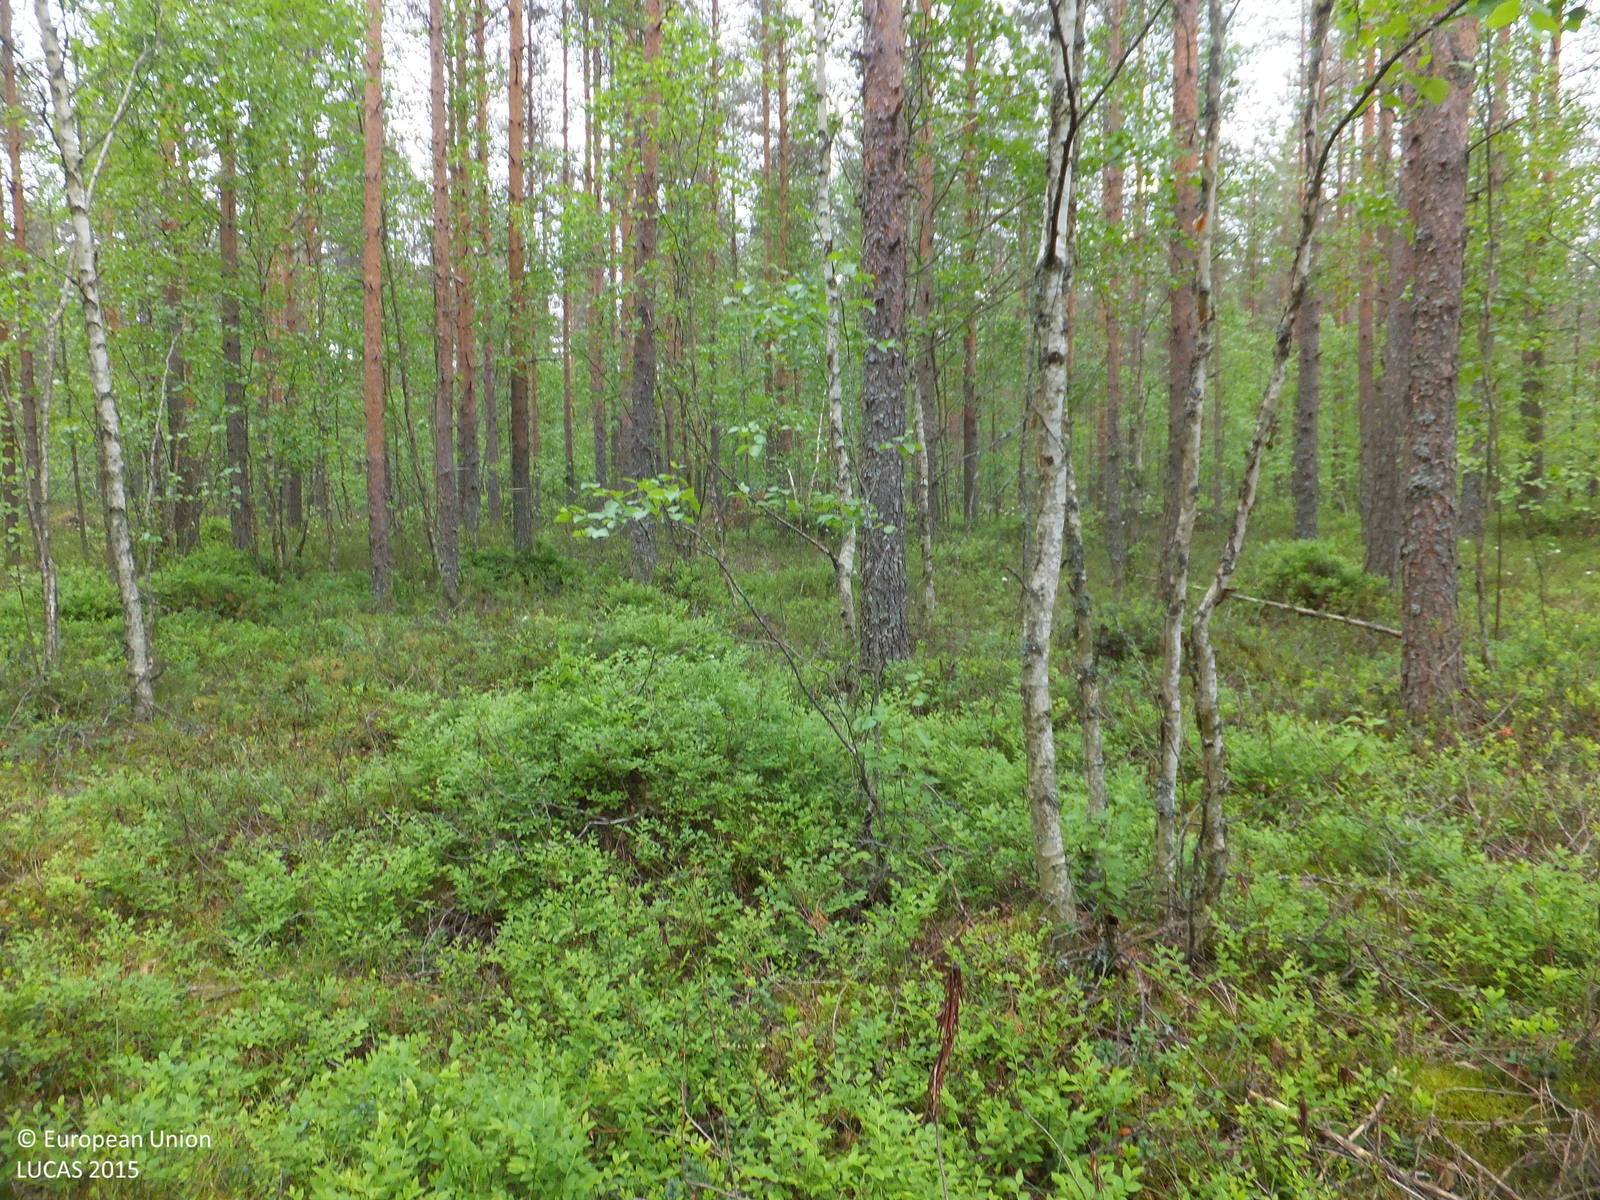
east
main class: Woodland
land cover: Pine dominated mixed woodland
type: boreal forest
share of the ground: > 75 %
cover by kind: coniferous forest trees 45 %, broadleaved forest trees 25 %, shrubs 20 %, lichens and mosses 10 %
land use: Forestry
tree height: > 5 m
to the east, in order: Pine dominated mixed woodland; Ditches and canals; Pine dominated mixed woodland; Ditches and canals; Groves; Tracks; Pine dominated mixed woodland; Ditches and canals; Pine dominated mixed woodland; Ditches and canals; Pine dominated mixed woodland
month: June
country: FI
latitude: 63.5265
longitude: 24.0860
